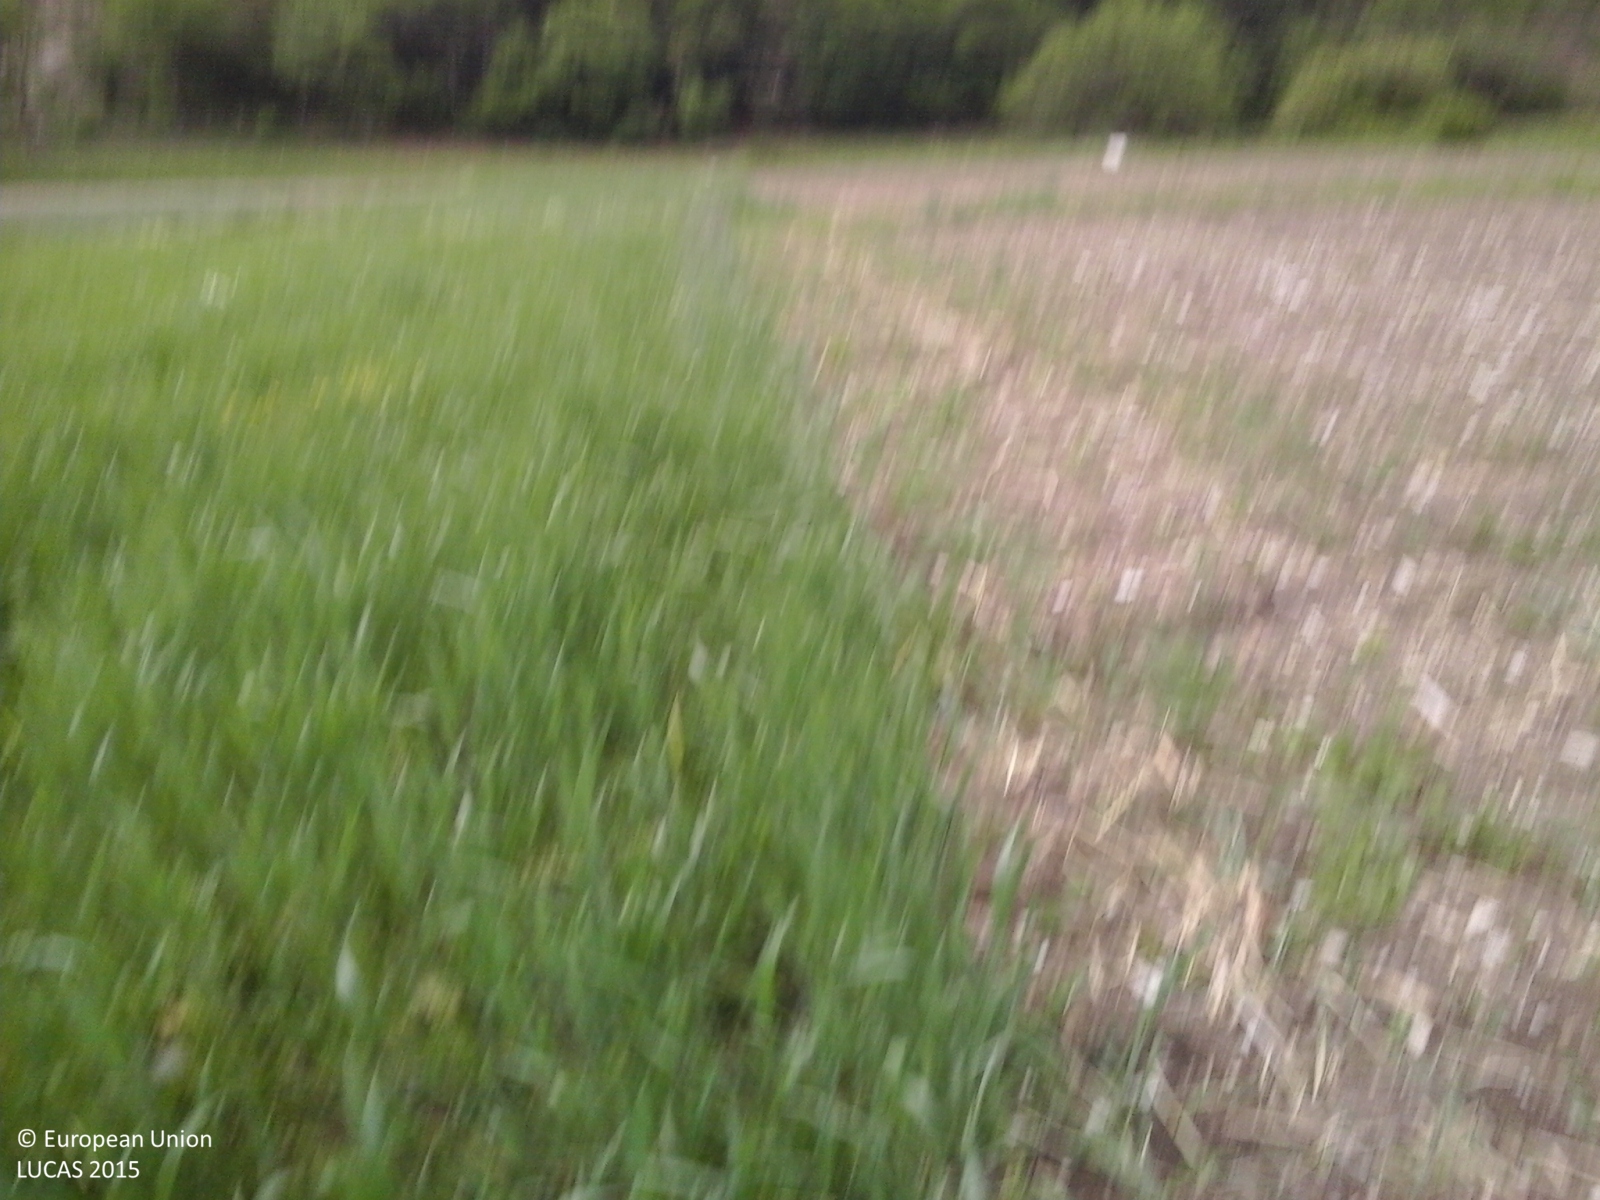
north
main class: Cropland
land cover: Mixed cereals for fodder
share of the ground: > 75 %
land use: Agriculture (excluding fallow land and kitchen gardens)
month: May
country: IT
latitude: 46.2726
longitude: 11.1793
